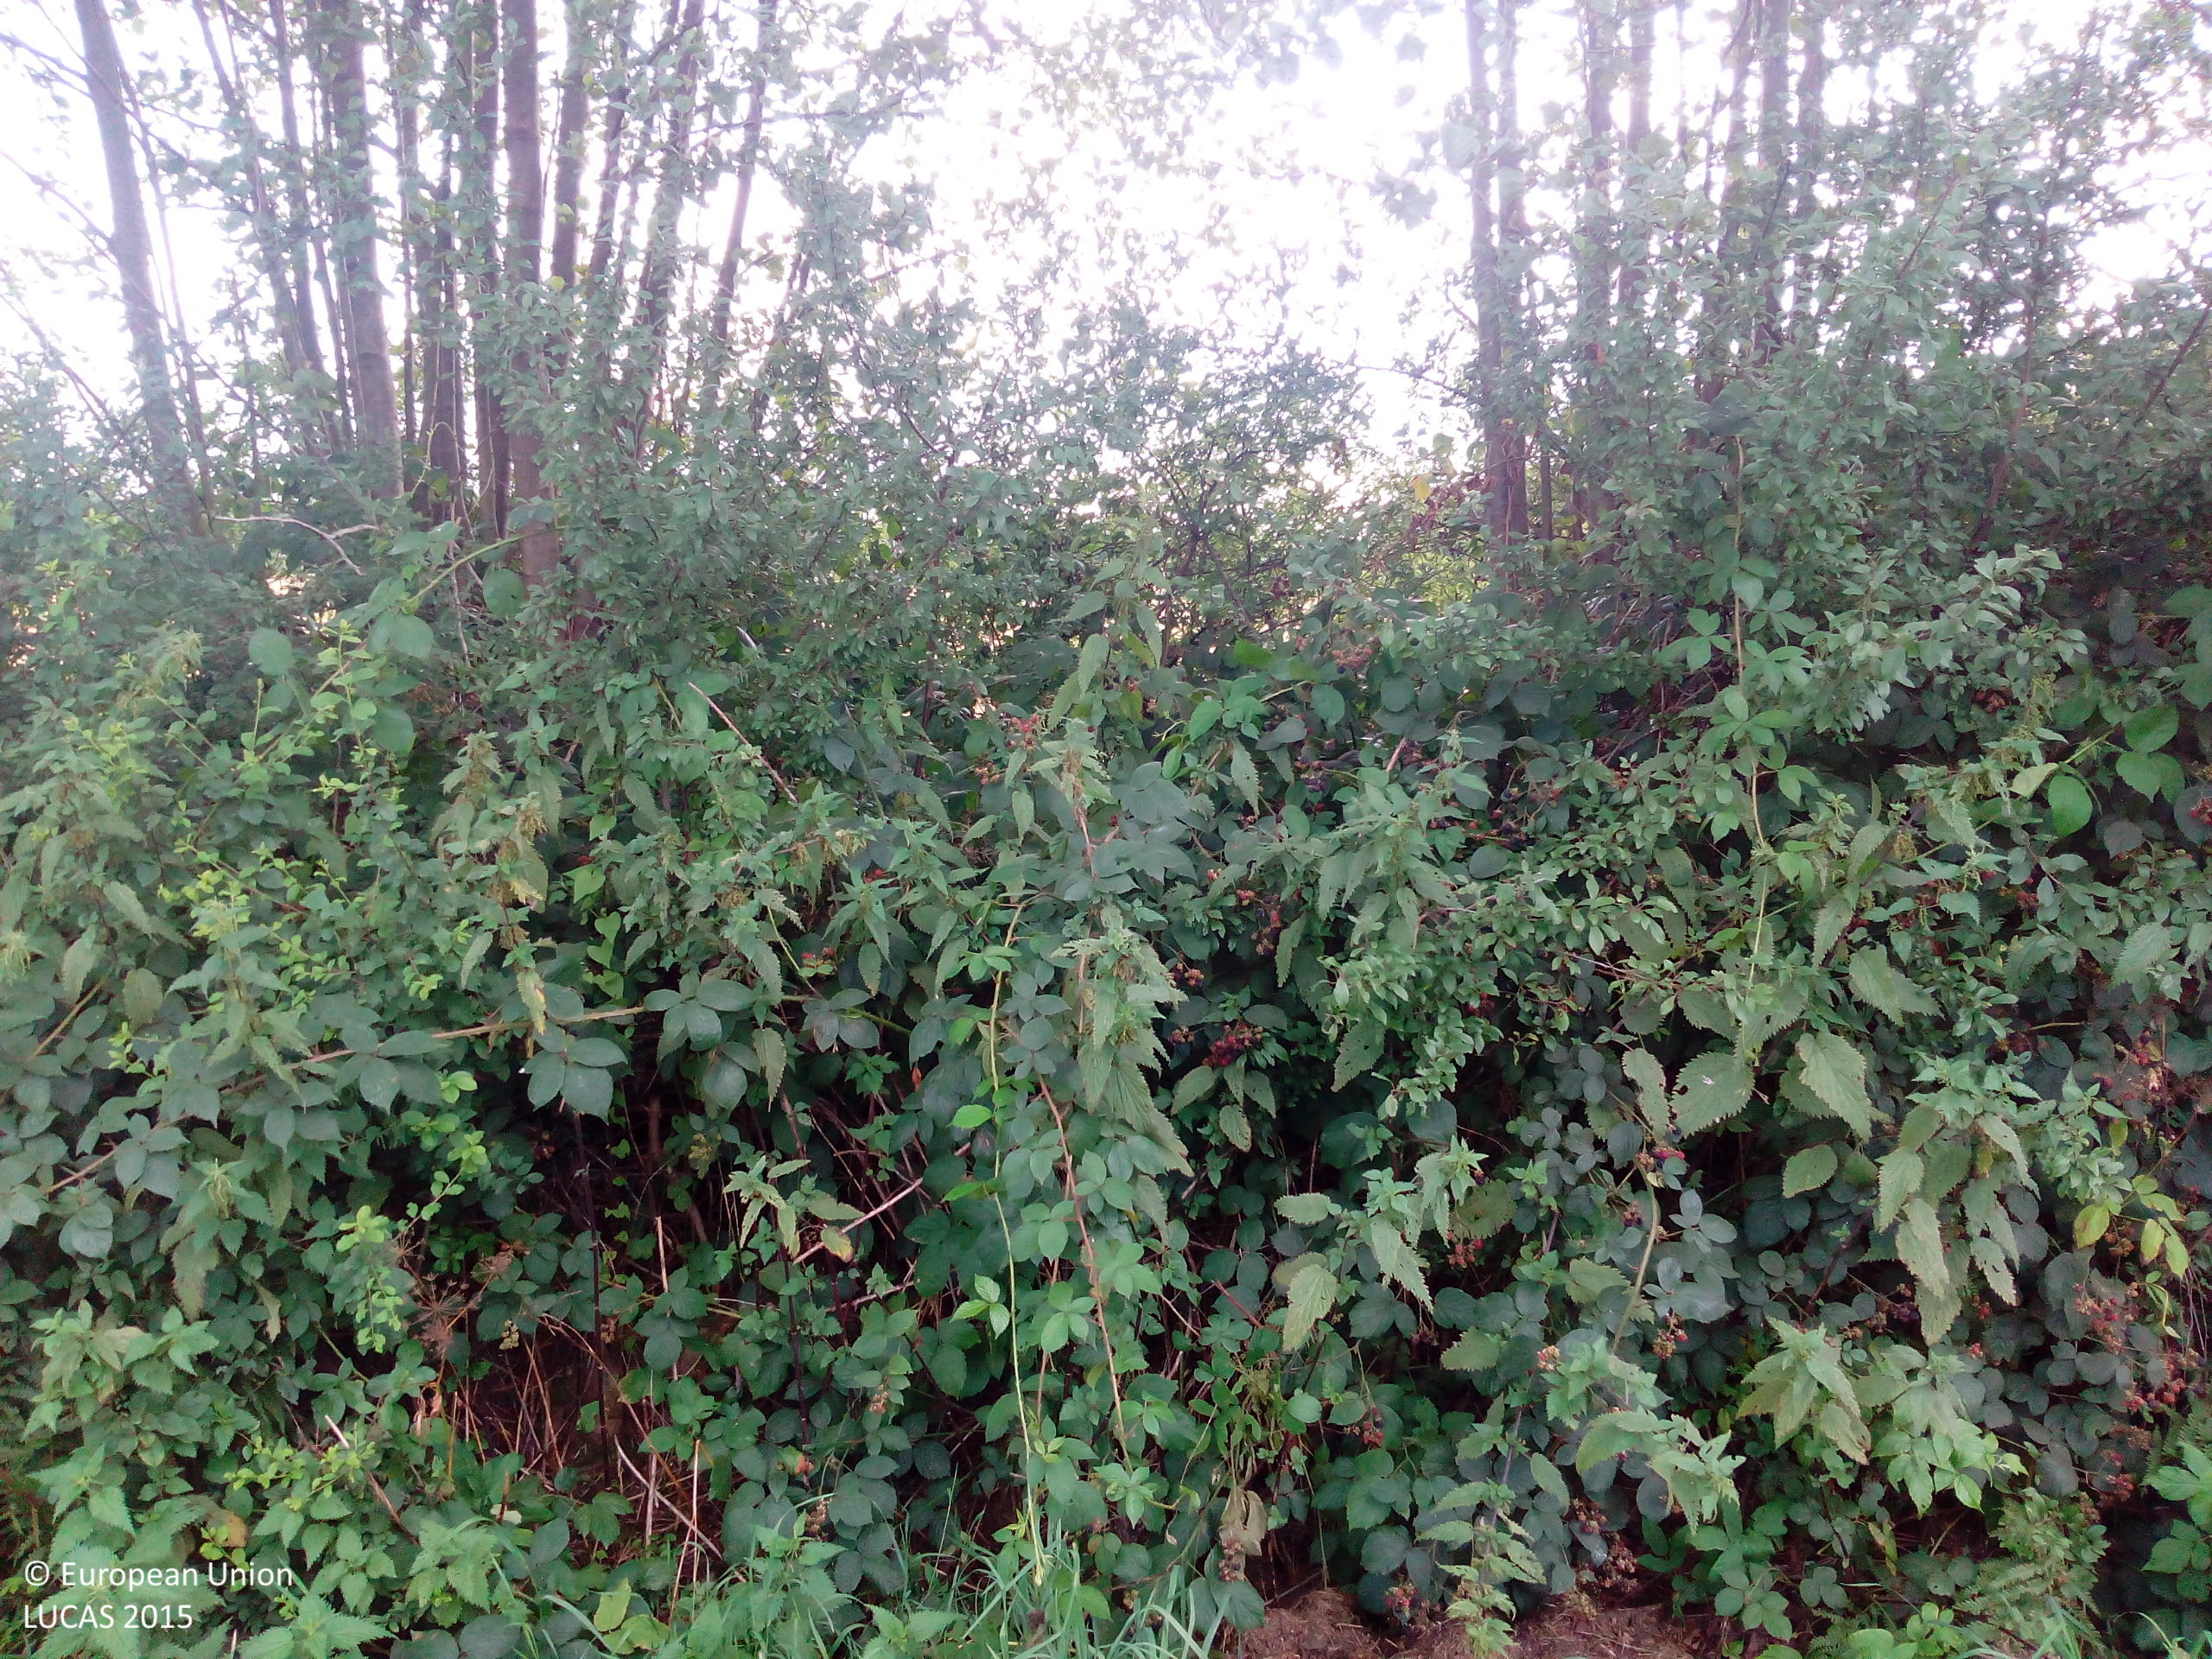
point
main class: Woodland
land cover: Broadleaved woodland
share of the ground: > 75 %
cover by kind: broadleaved forest trees 100 %
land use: Road transport
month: August
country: DE
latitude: 53.7973
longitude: 9.9545
